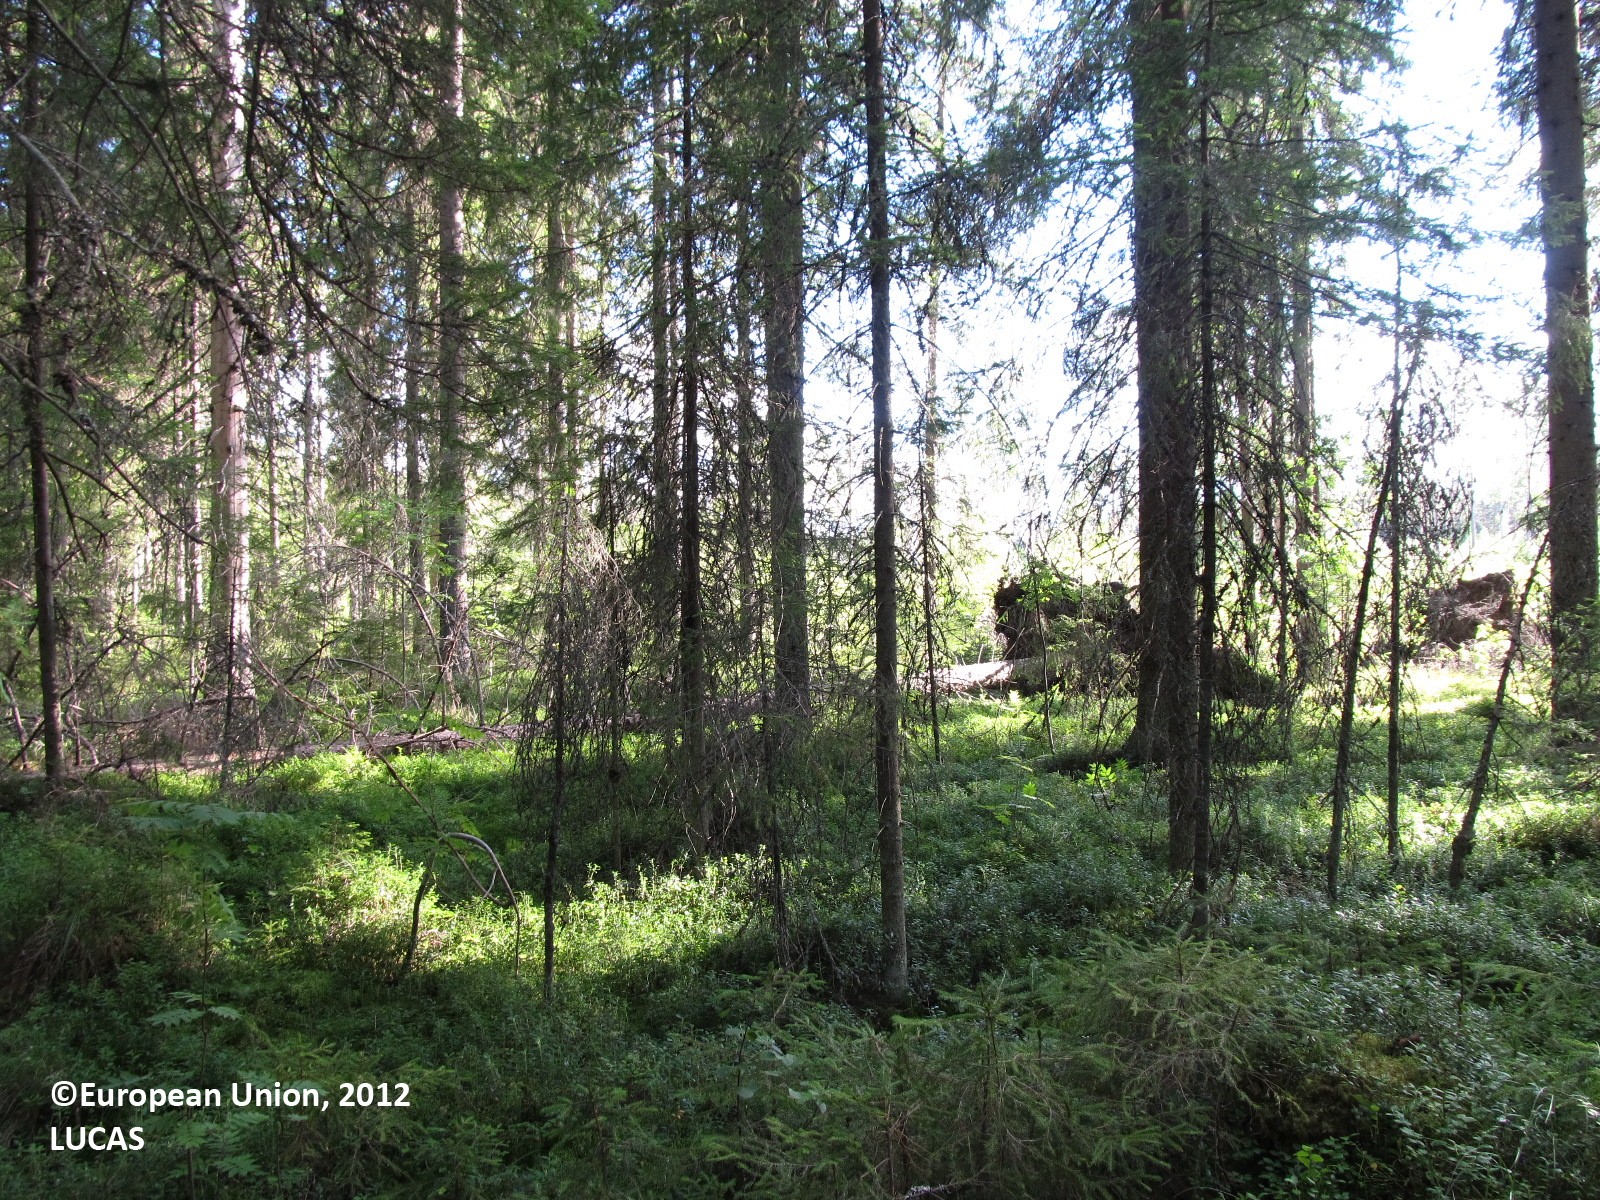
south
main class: Woodland
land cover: Spruce dominated coniferous woodland
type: boreal forest
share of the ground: 25 - 50 %
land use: Forestry
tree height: > 5 m
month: August
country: FI
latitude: 61.8661
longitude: 27.8460
